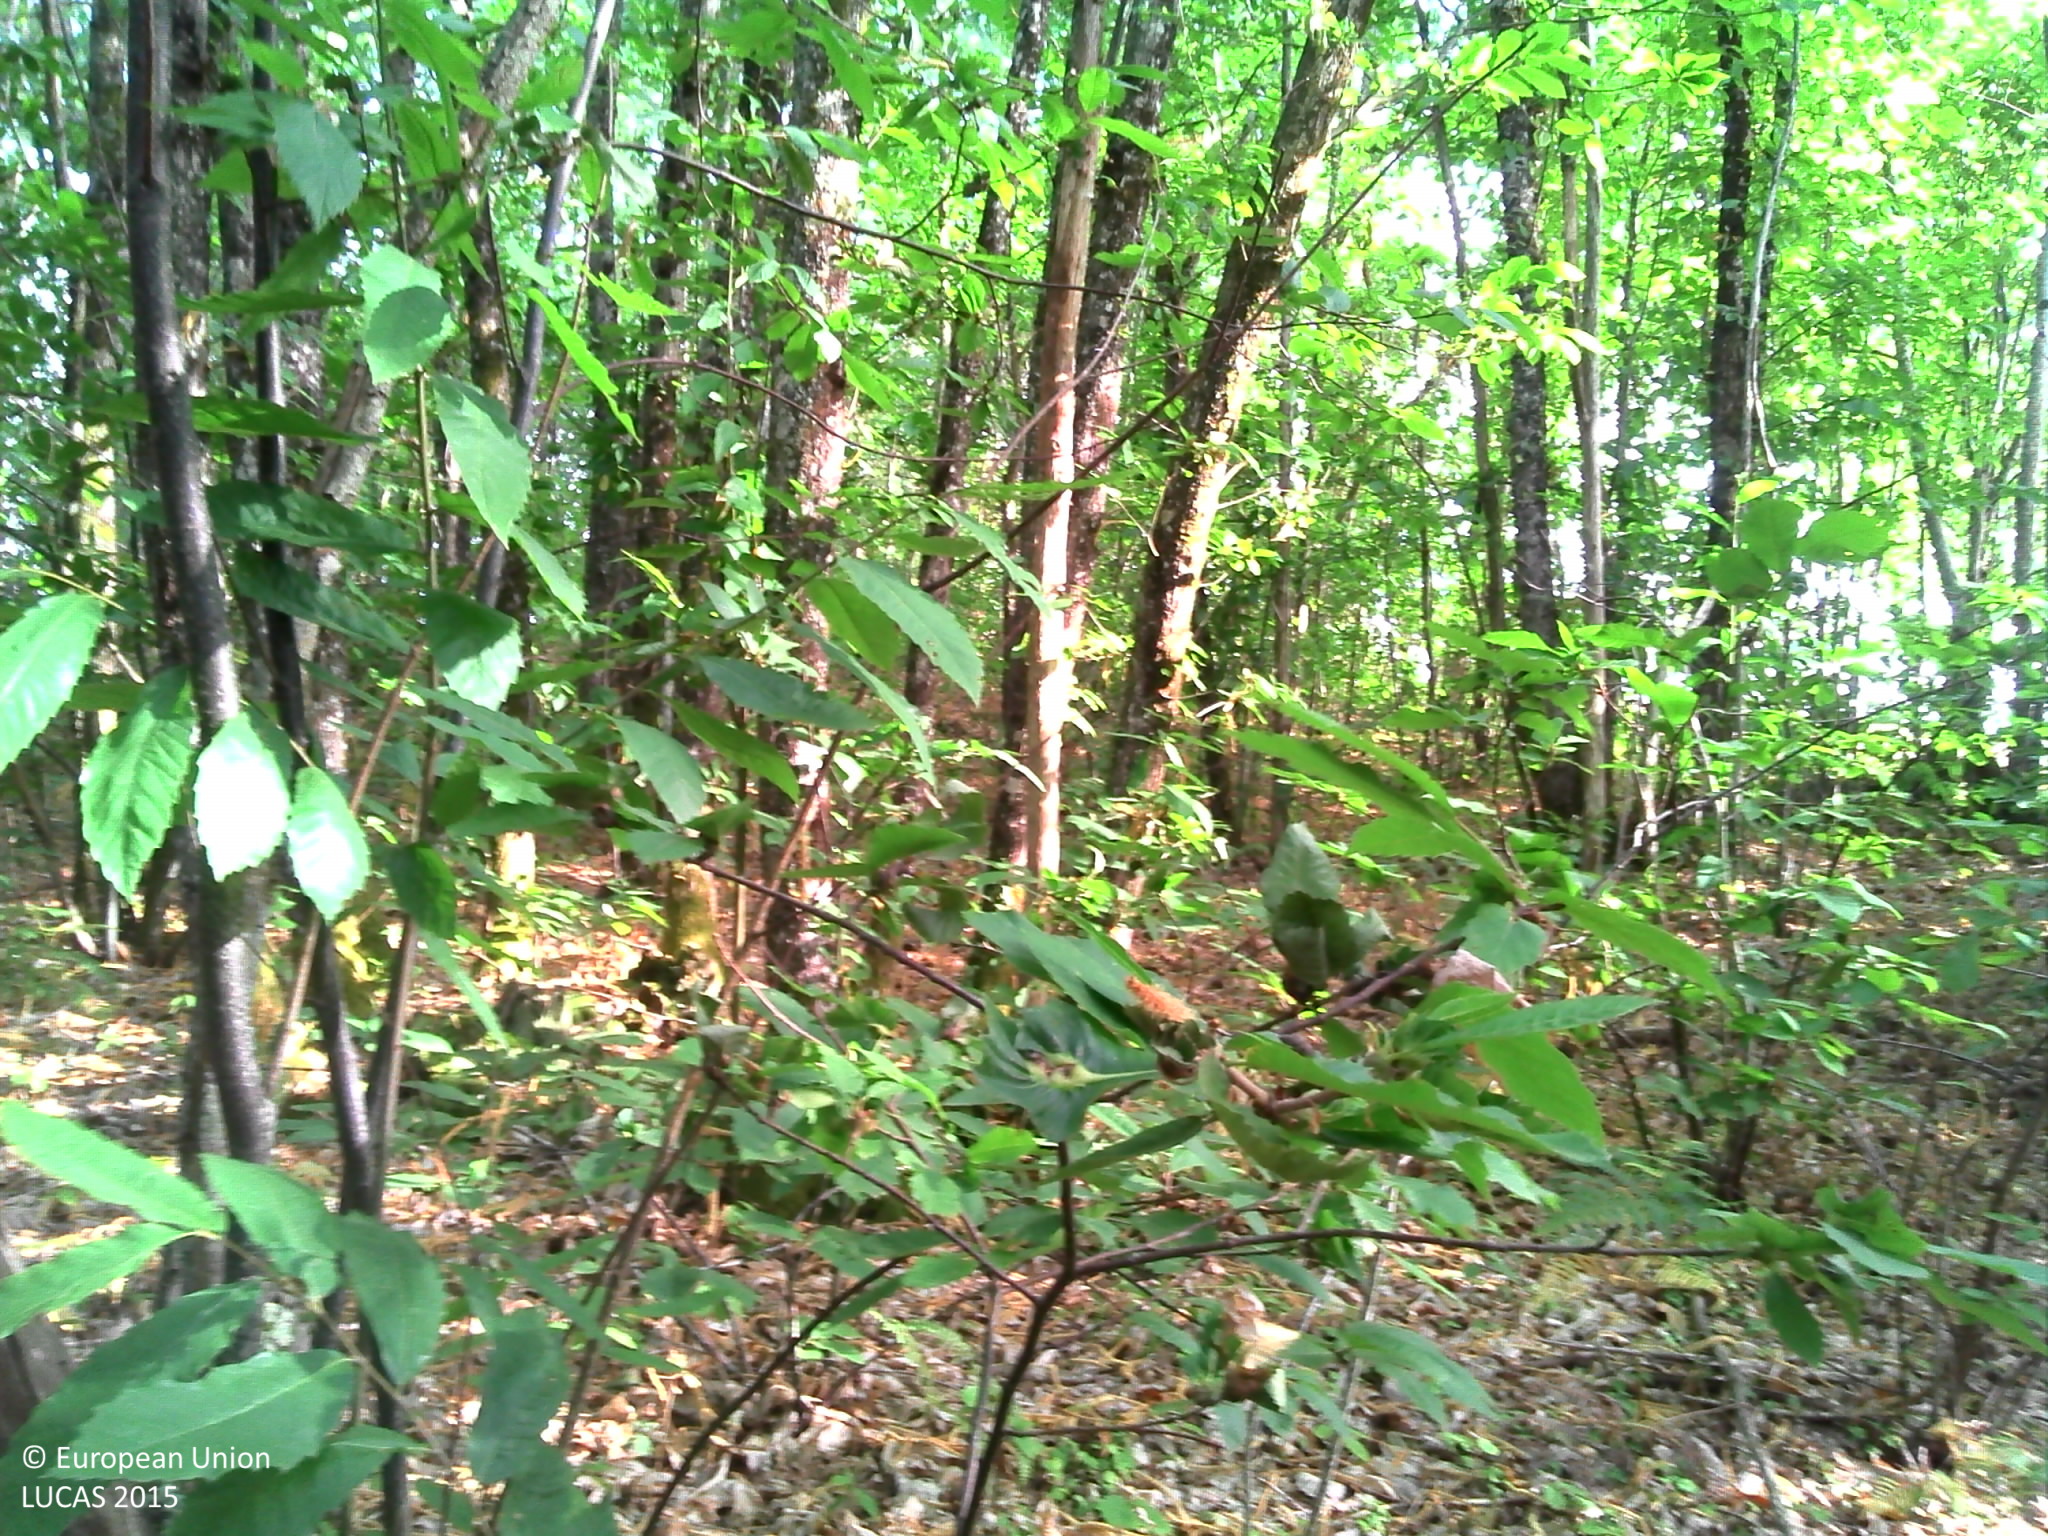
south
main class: Woodland
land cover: Broadleaved woodland
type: thermophilous deciduous forest
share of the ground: > 75 %
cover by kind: broadleaved forest trees 80 %, shrubs 10 %, herbaceous plants 5 %, lichens and mosses 5 %
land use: Forestry
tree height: > 5 m
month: July
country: FR
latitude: 45.0262
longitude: 0.5599
